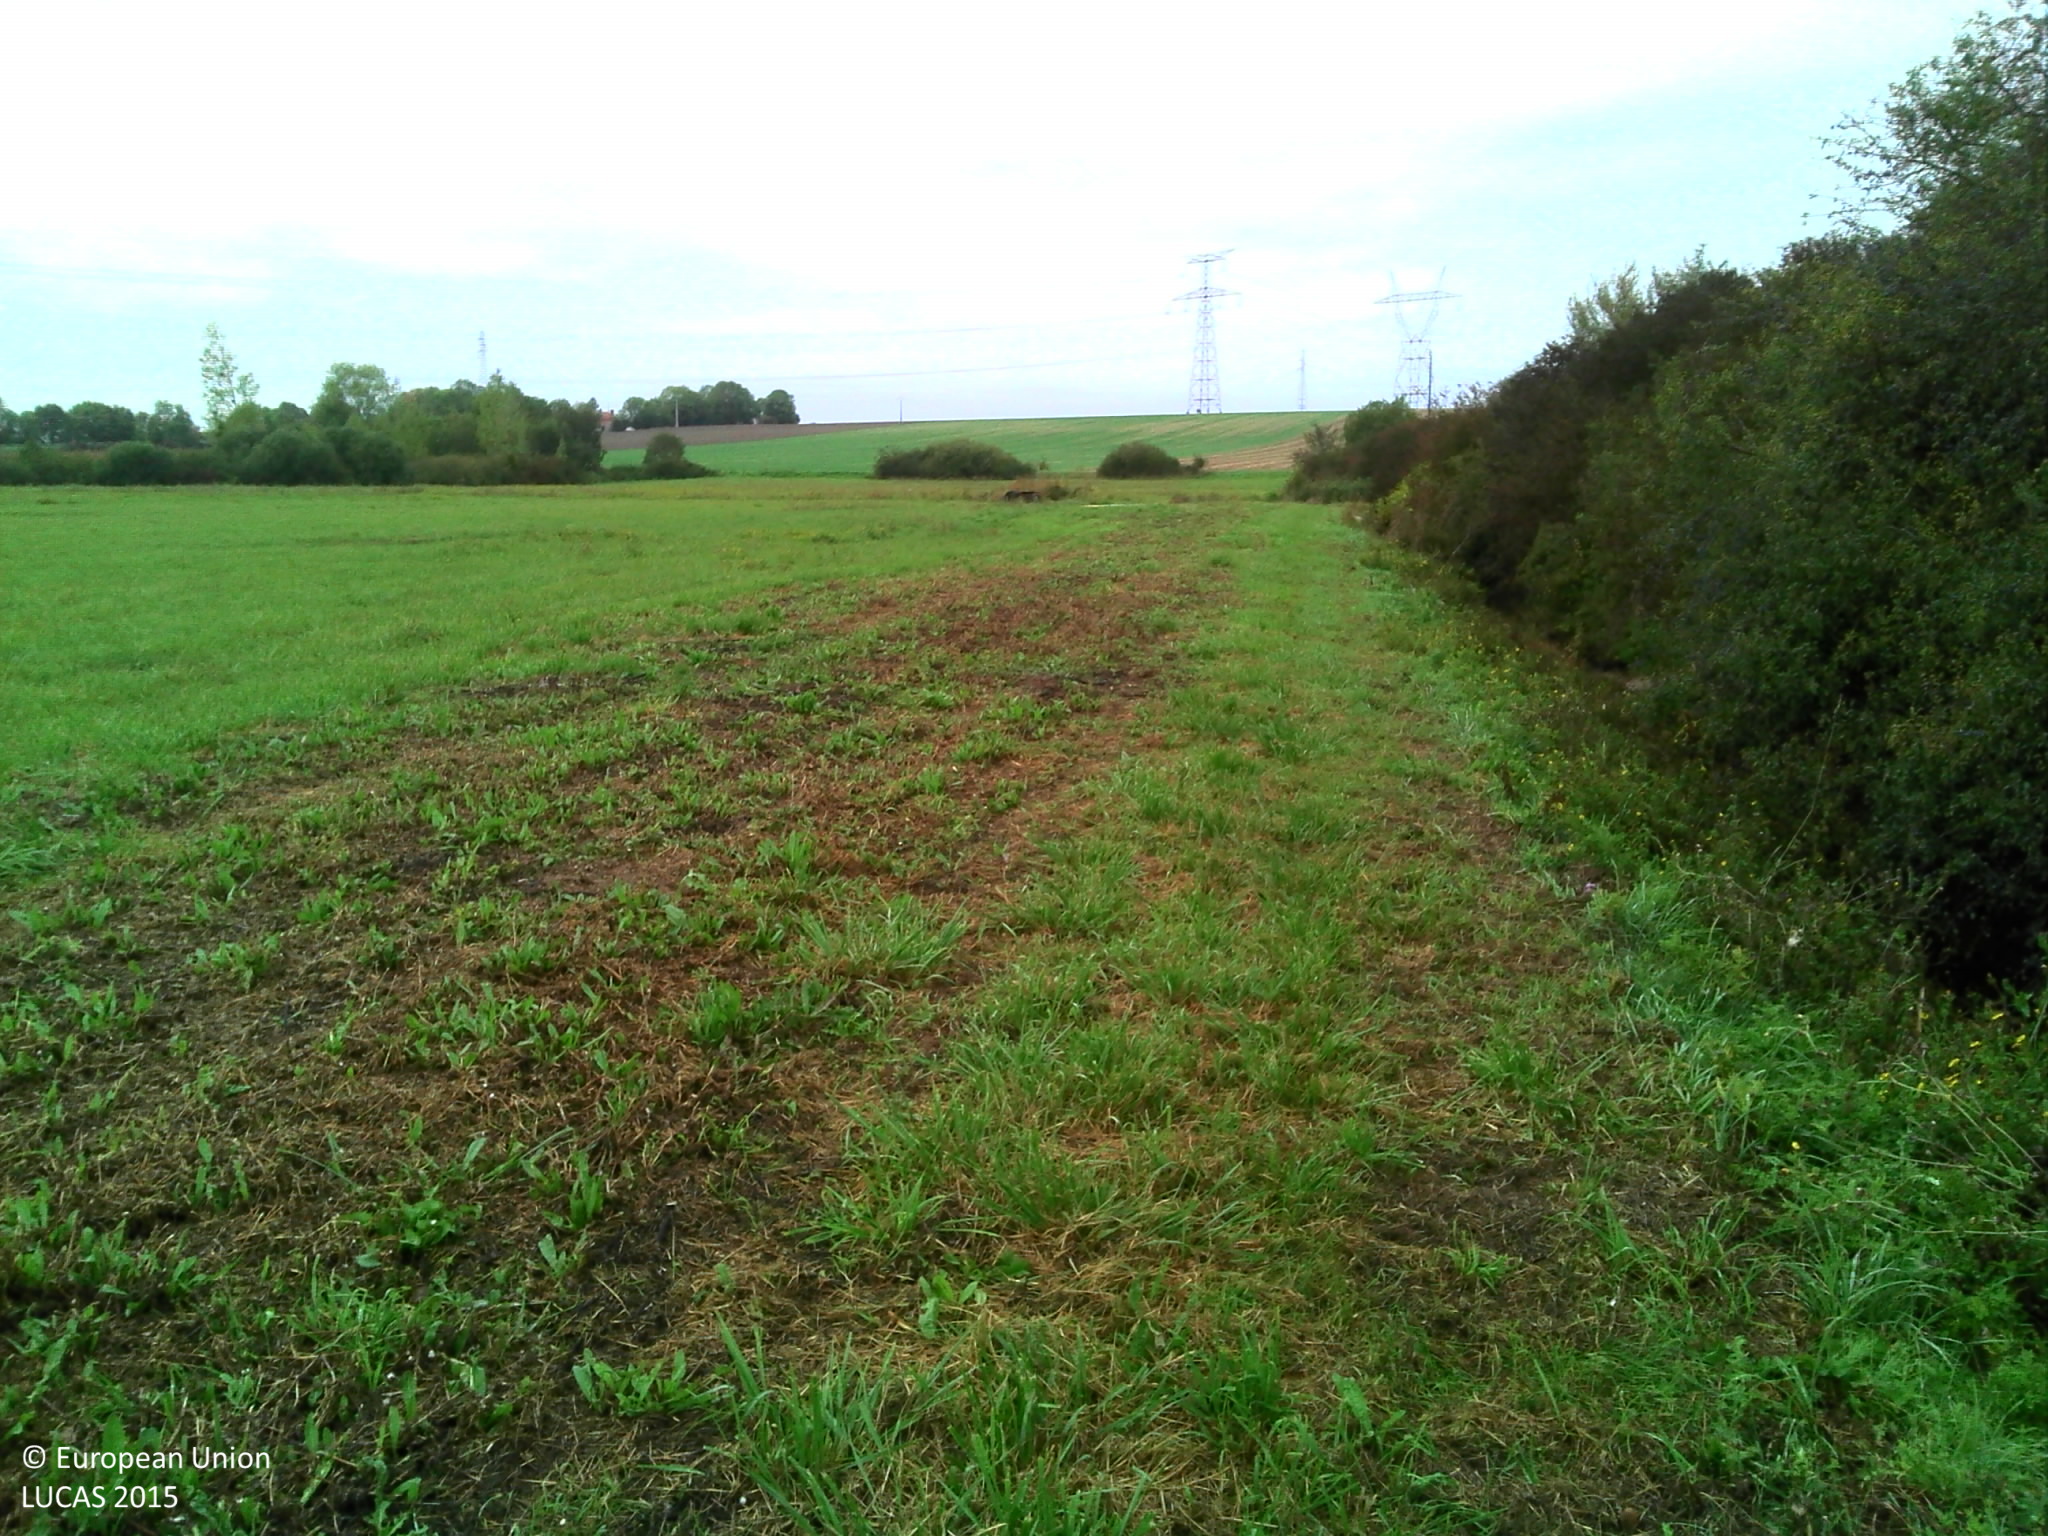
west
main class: Grassland
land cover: Grassland without tree/shrub cover
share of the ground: > 75 %
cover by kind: herbaceous plants 100 %
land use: Agriculture (excluding fallow land and kitchen gardens)
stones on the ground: < 10 %
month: October
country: FR
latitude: 48.2702
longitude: 4.2169
